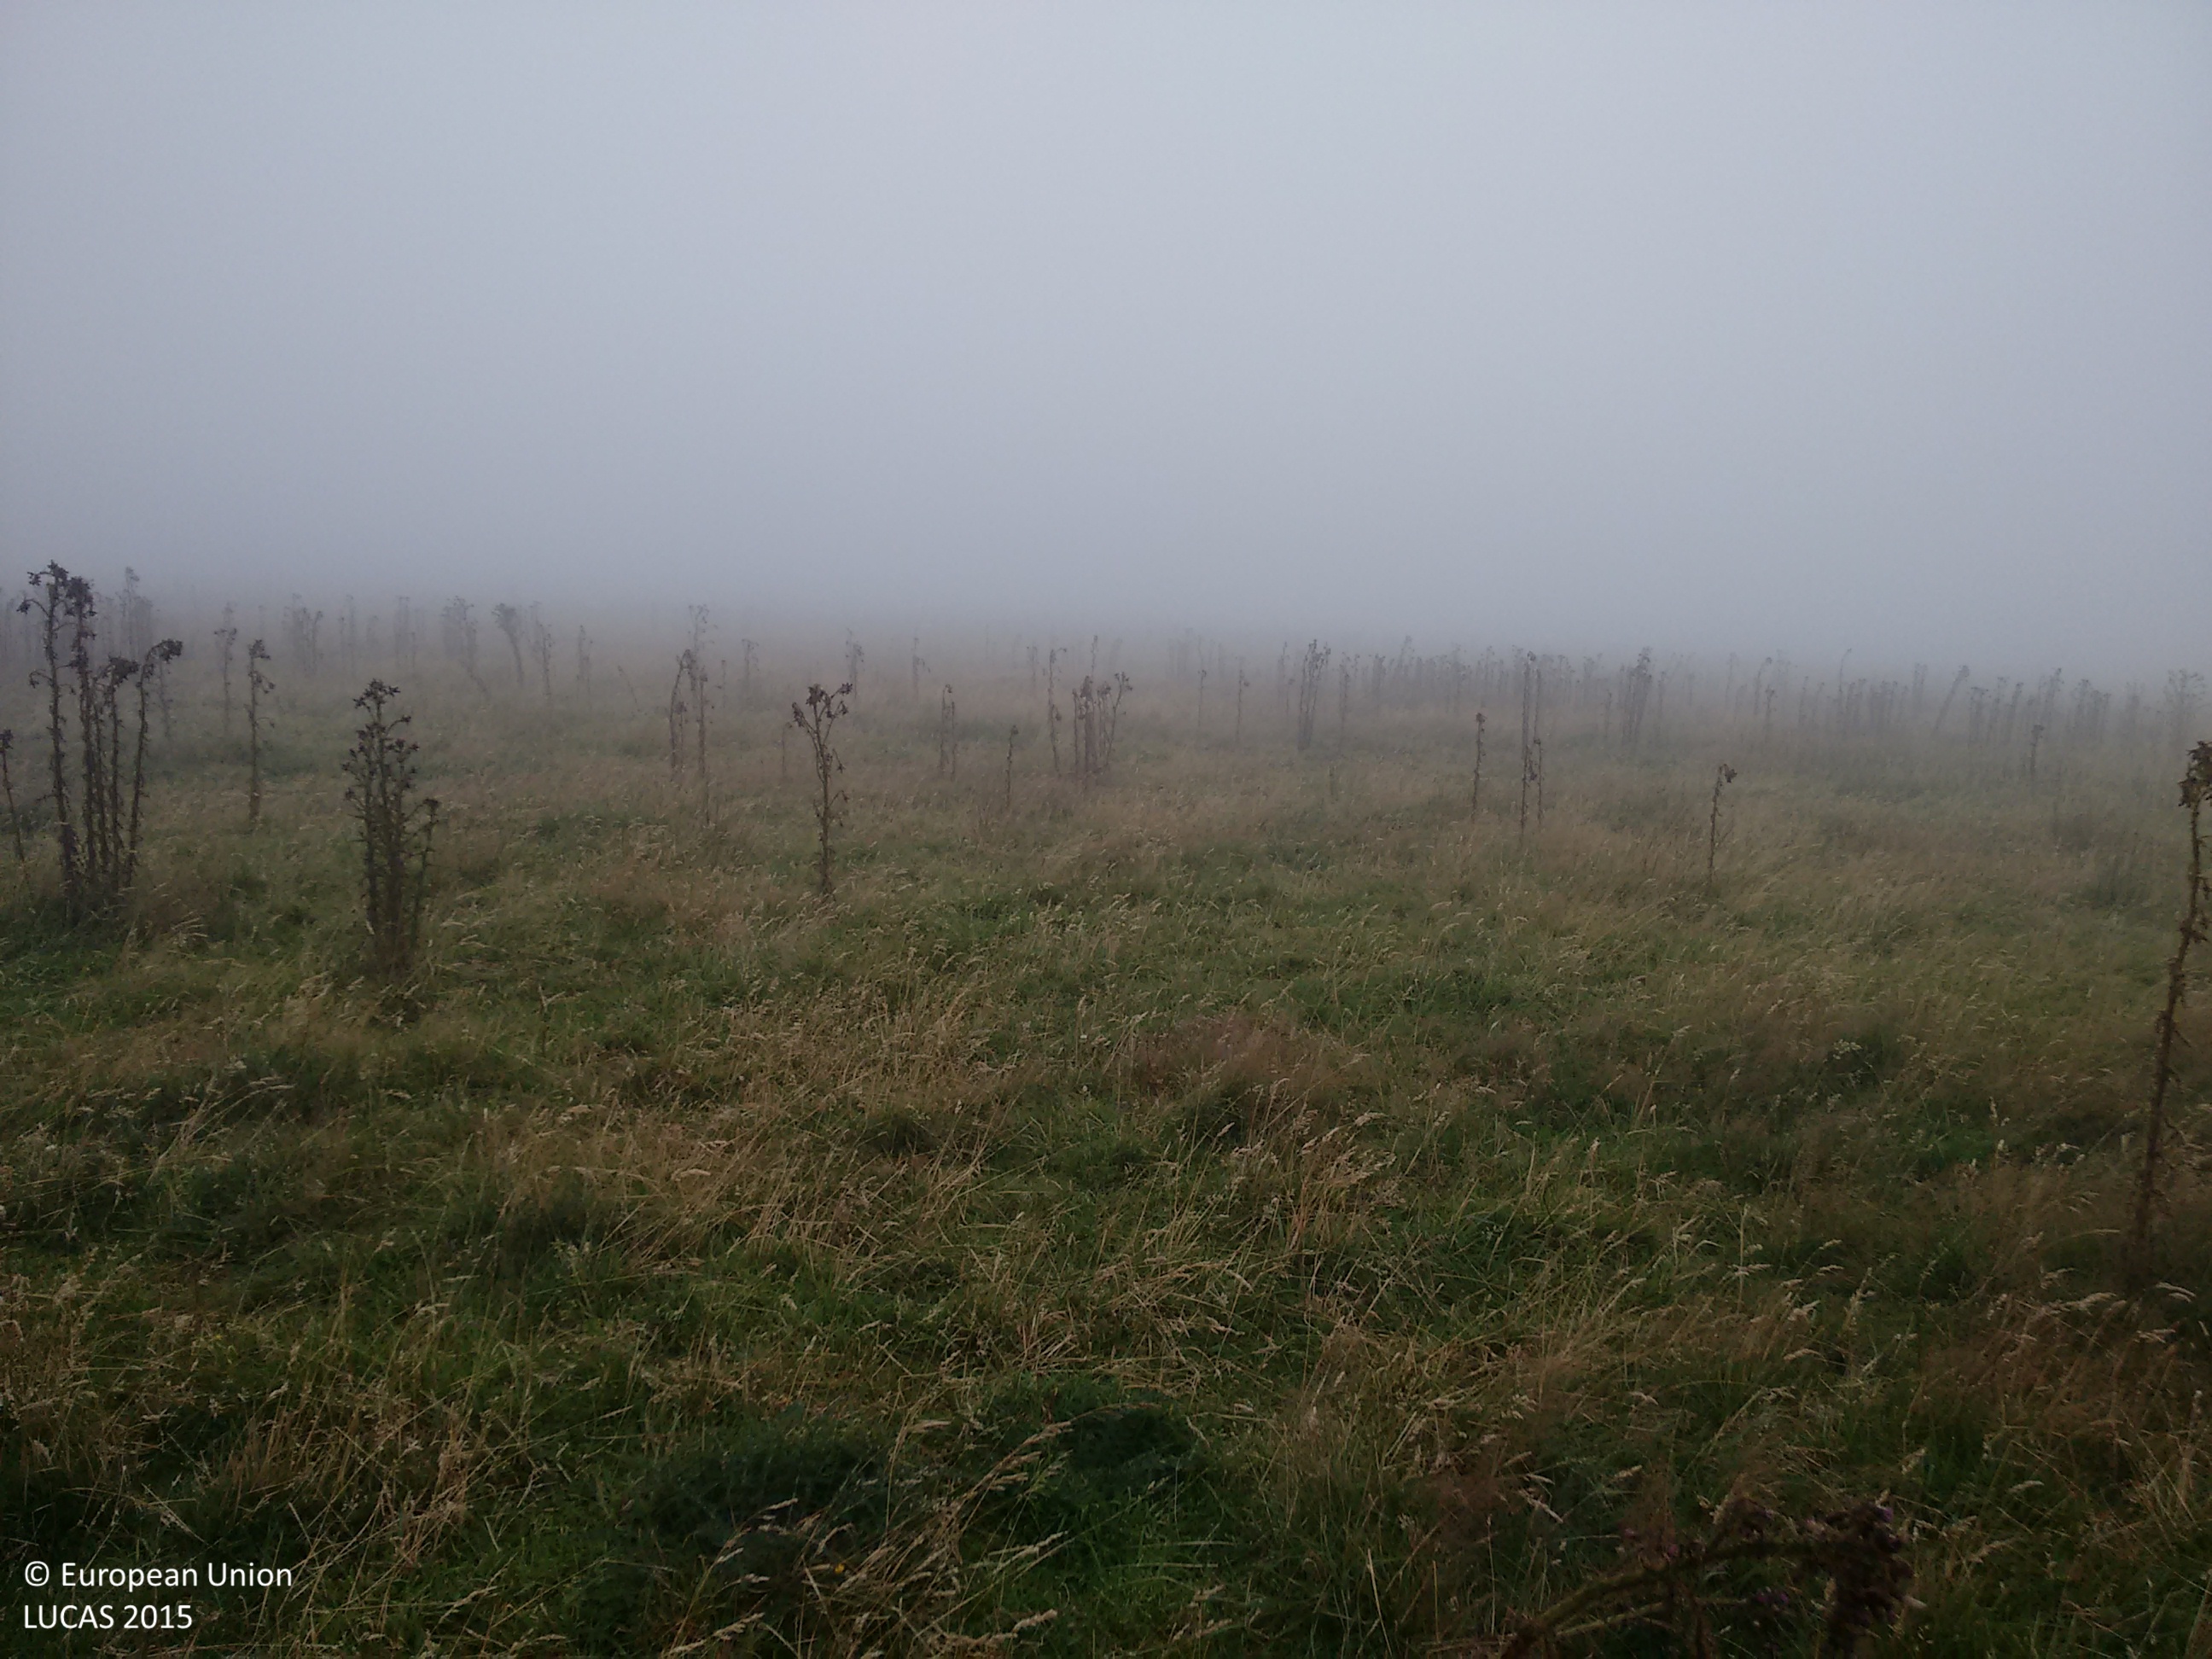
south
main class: Grassland
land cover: Grassland without tree/shrub cover
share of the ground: > 75 %
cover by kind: herbaceous plants 100 %
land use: Agriculture (excluding fallow land and kitchen gardens)
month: August
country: GB
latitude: 51.1257
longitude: -3.8219
